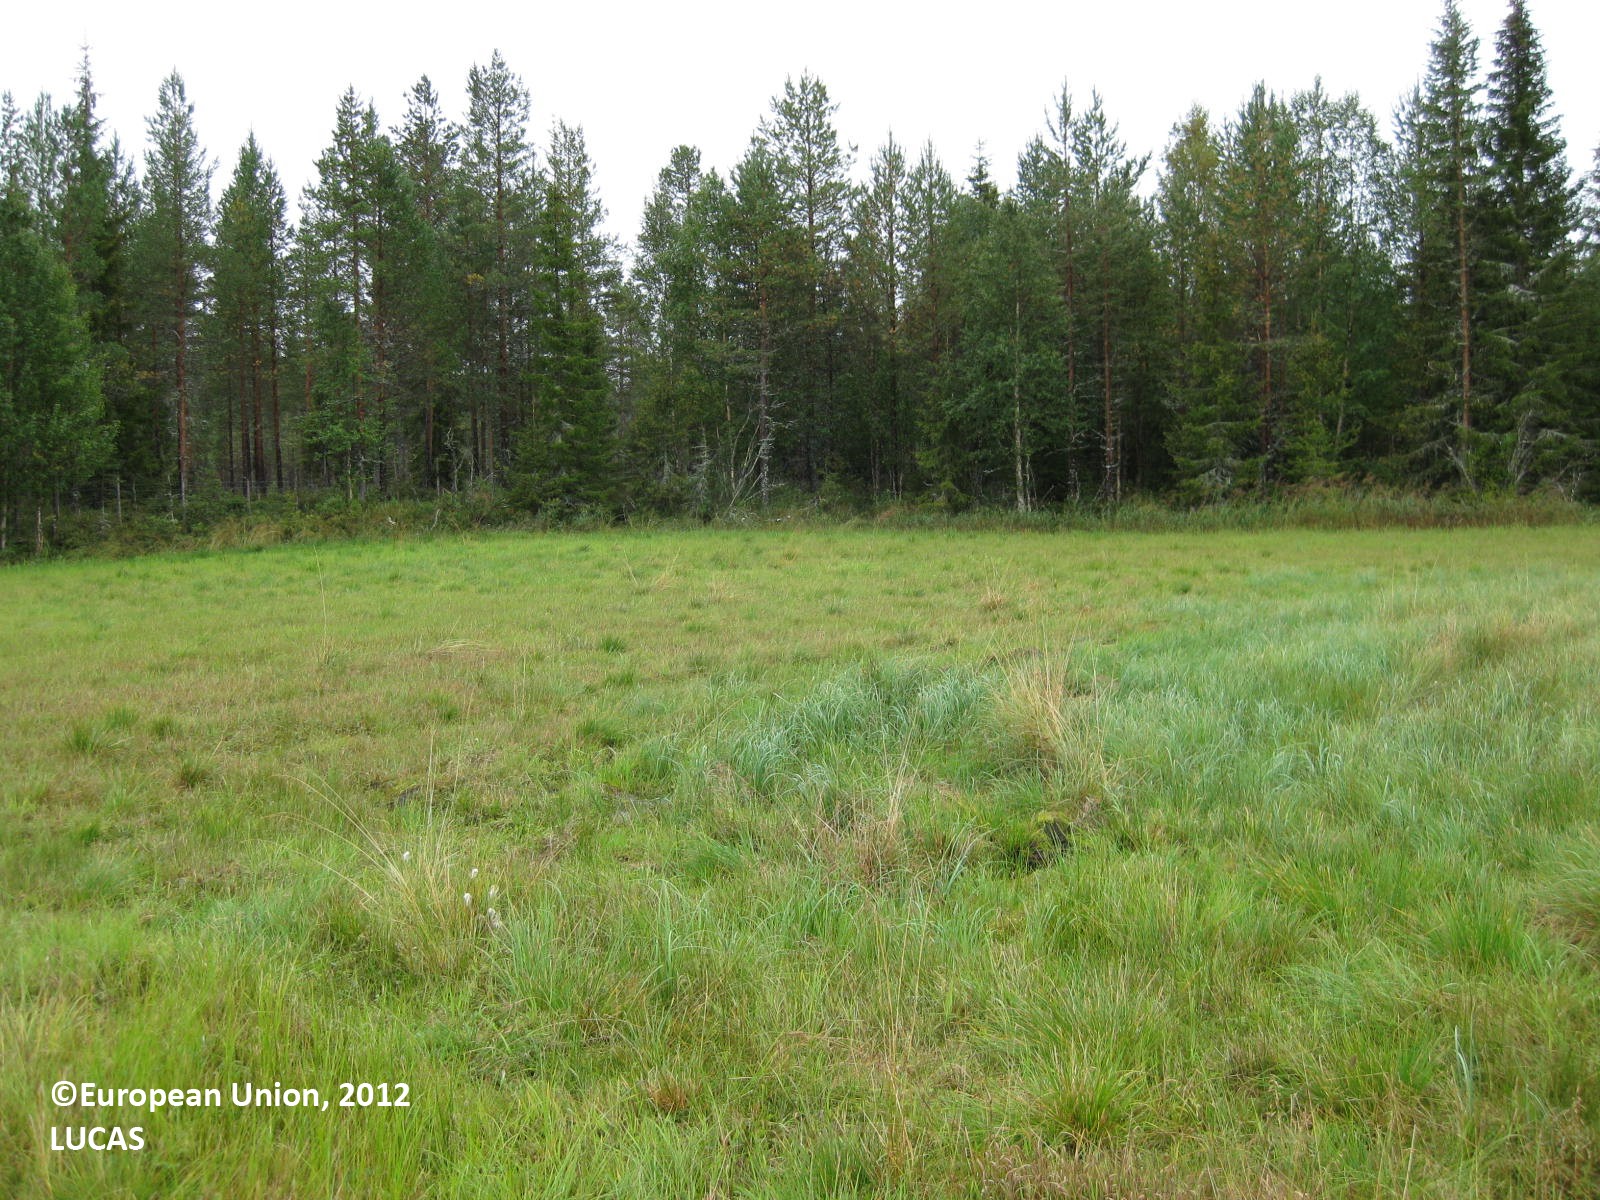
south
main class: Grassland
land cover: Grassland without tree/shrub cover
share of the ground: > 75 %
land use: Agriculture (excluding fallow land and kitchen gardens)
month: August
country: FI
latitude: 66.0293
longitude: 28.6206
